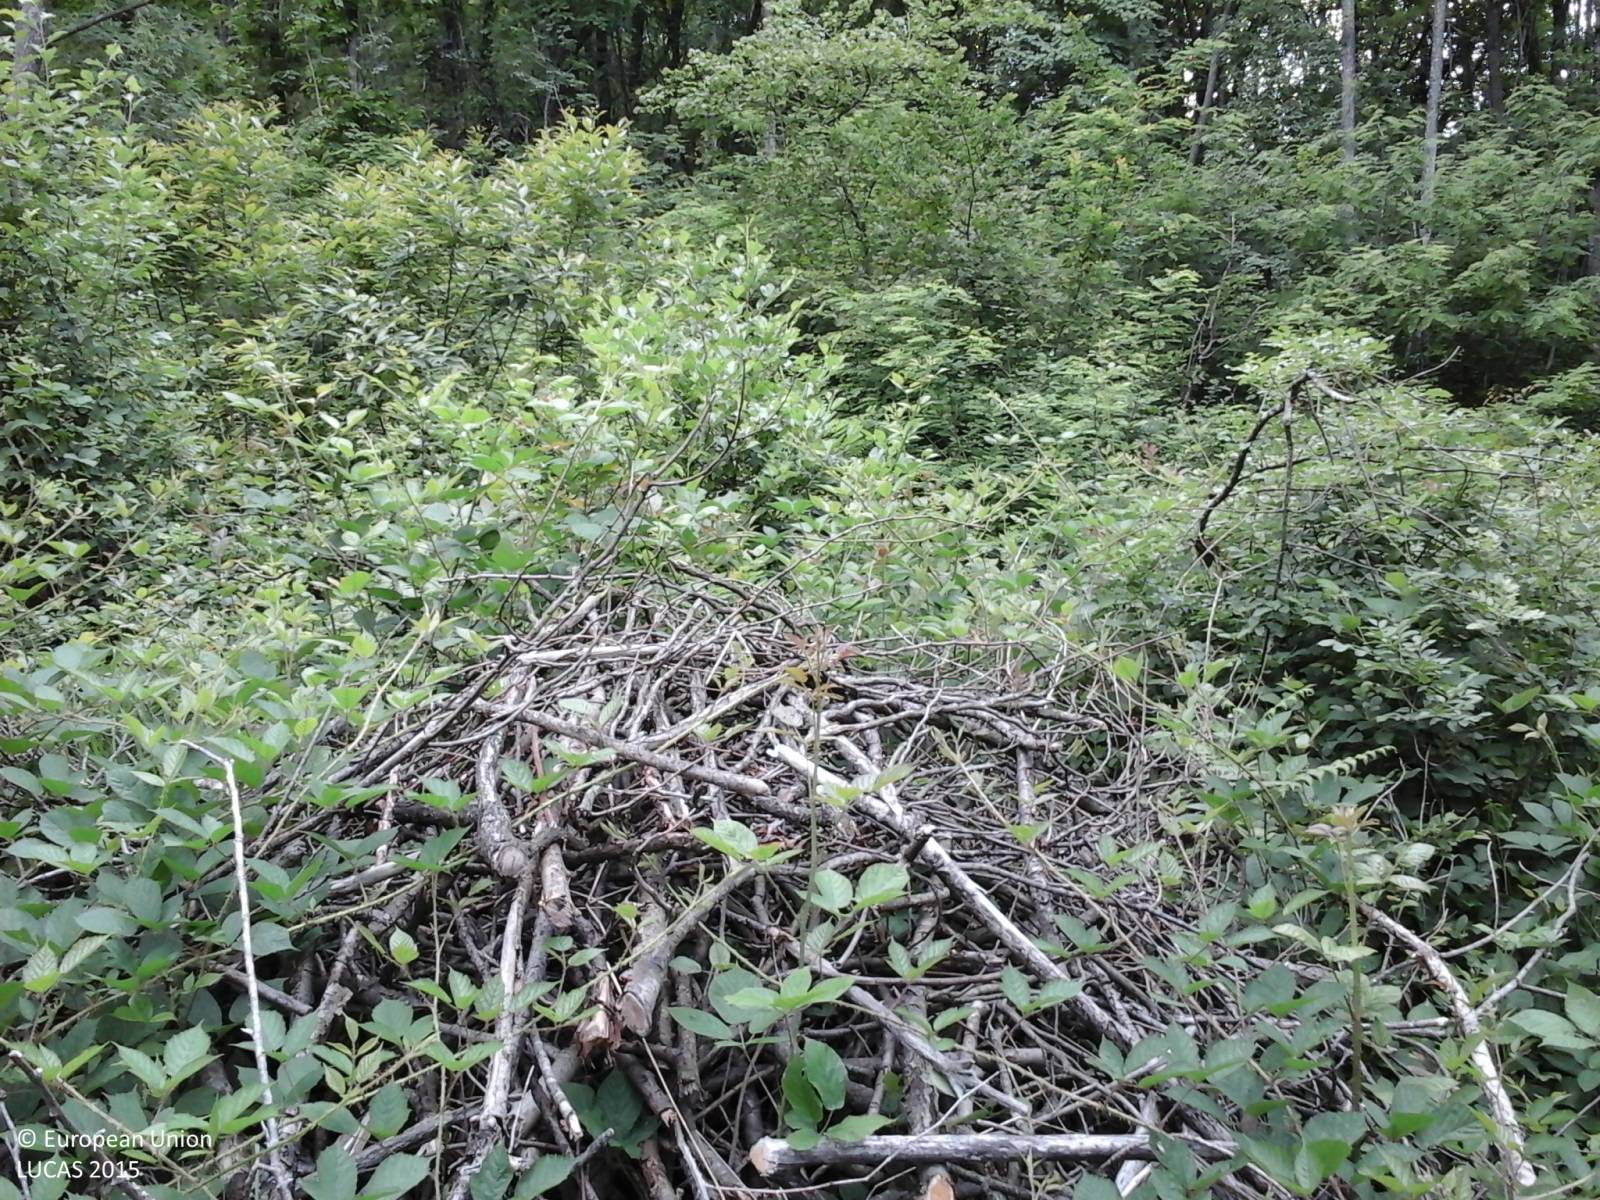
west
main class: Woodland
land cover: Broadleaved woodland
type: mesophytic deciduous forest
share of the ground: > 75 %
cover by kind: broadleaved forest trees 85 %, shrubs 10 %, herbaceous plants 5 %
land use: Forestry
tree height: > 5 m
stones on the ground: 25 - 50 %
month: May
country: IT
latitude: 46.1749
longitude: 13.2737
